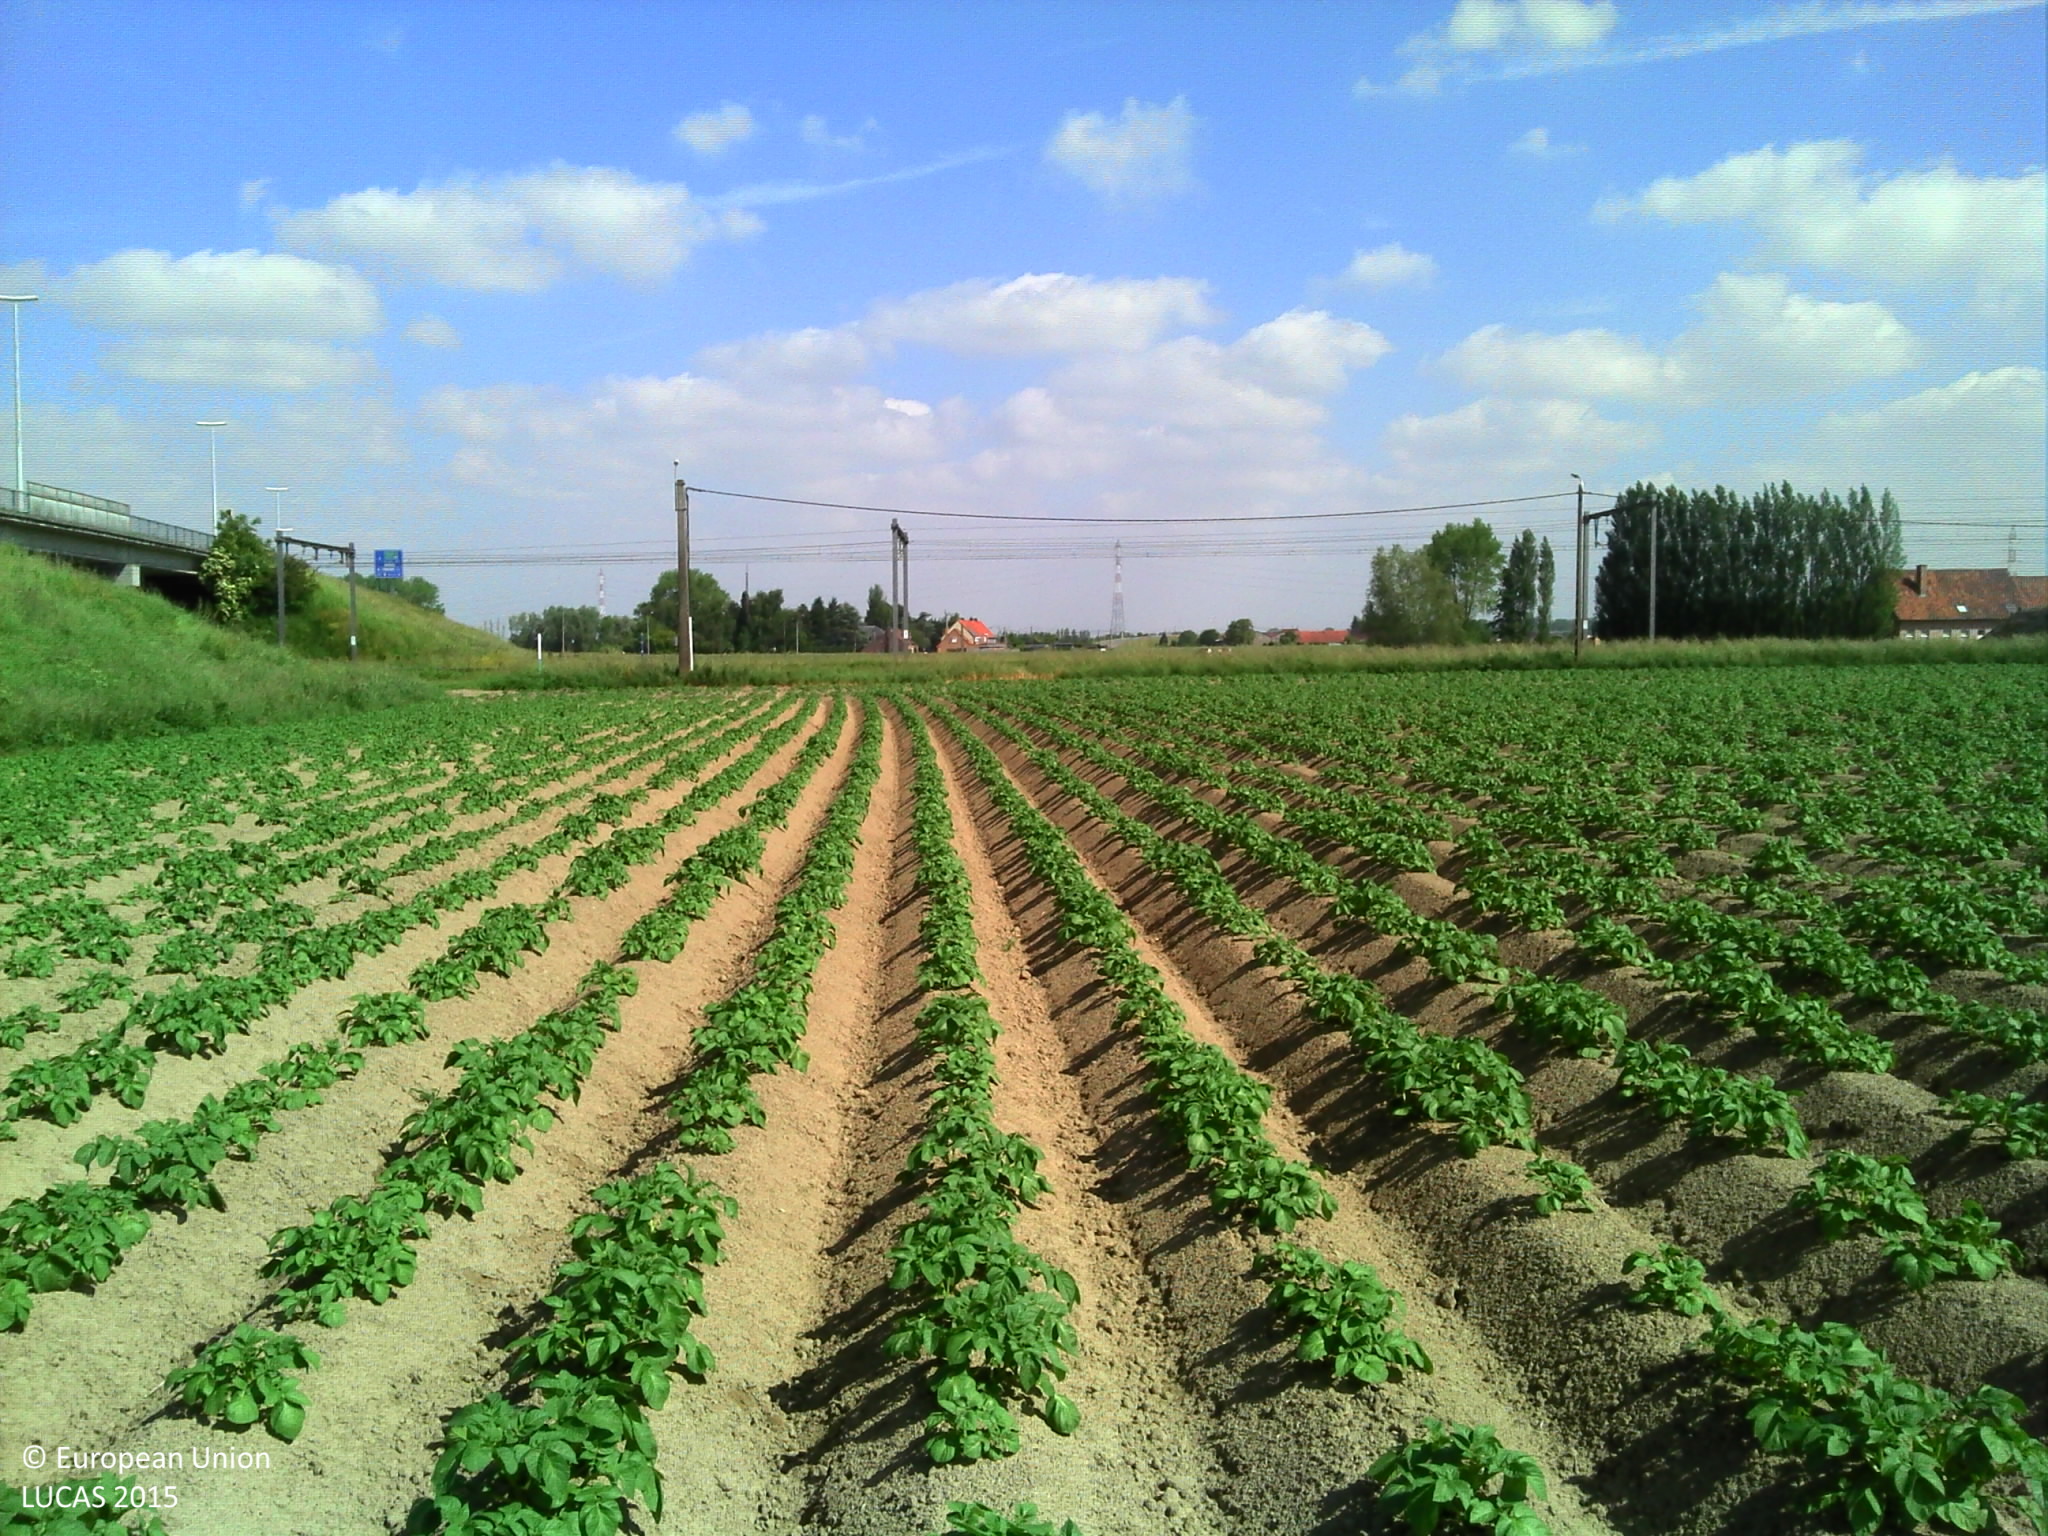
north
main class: Cropland
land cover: Potatoes
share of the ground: 10 - 25 %
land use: Agriculture (excluding fallow land and kitchen gardens)
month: June
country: BE
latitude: 50.8075
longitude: 3.1364
